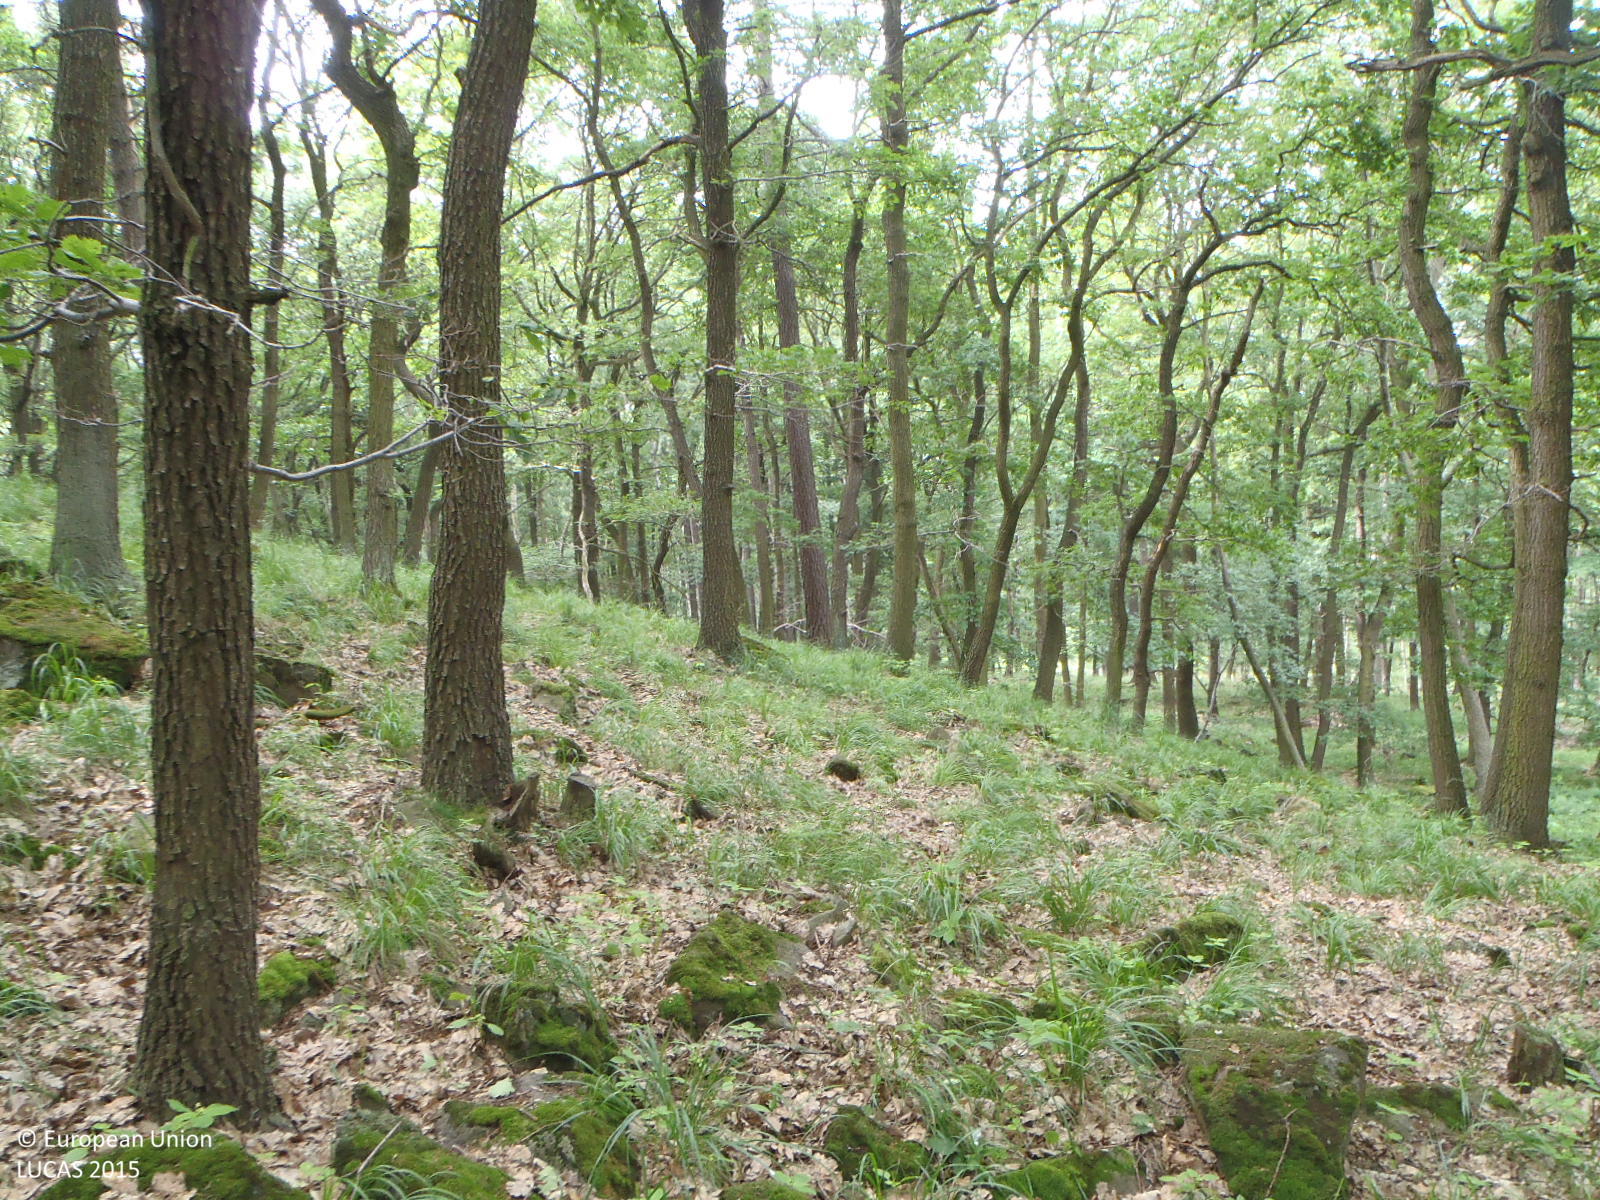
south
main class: Woodland
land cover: Broadleaved woodland
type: acidophilous oak and oak-birch forest
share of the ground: > 75 %
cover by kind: broadleaved forest trees 85 %, coniferous forest trees 5 %, herbaceous plants 5 %, lichens and mosses 5 %
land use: Forestry
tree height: > 5 m
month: June
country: CZ
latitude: 50.5153
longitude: 13.8509
